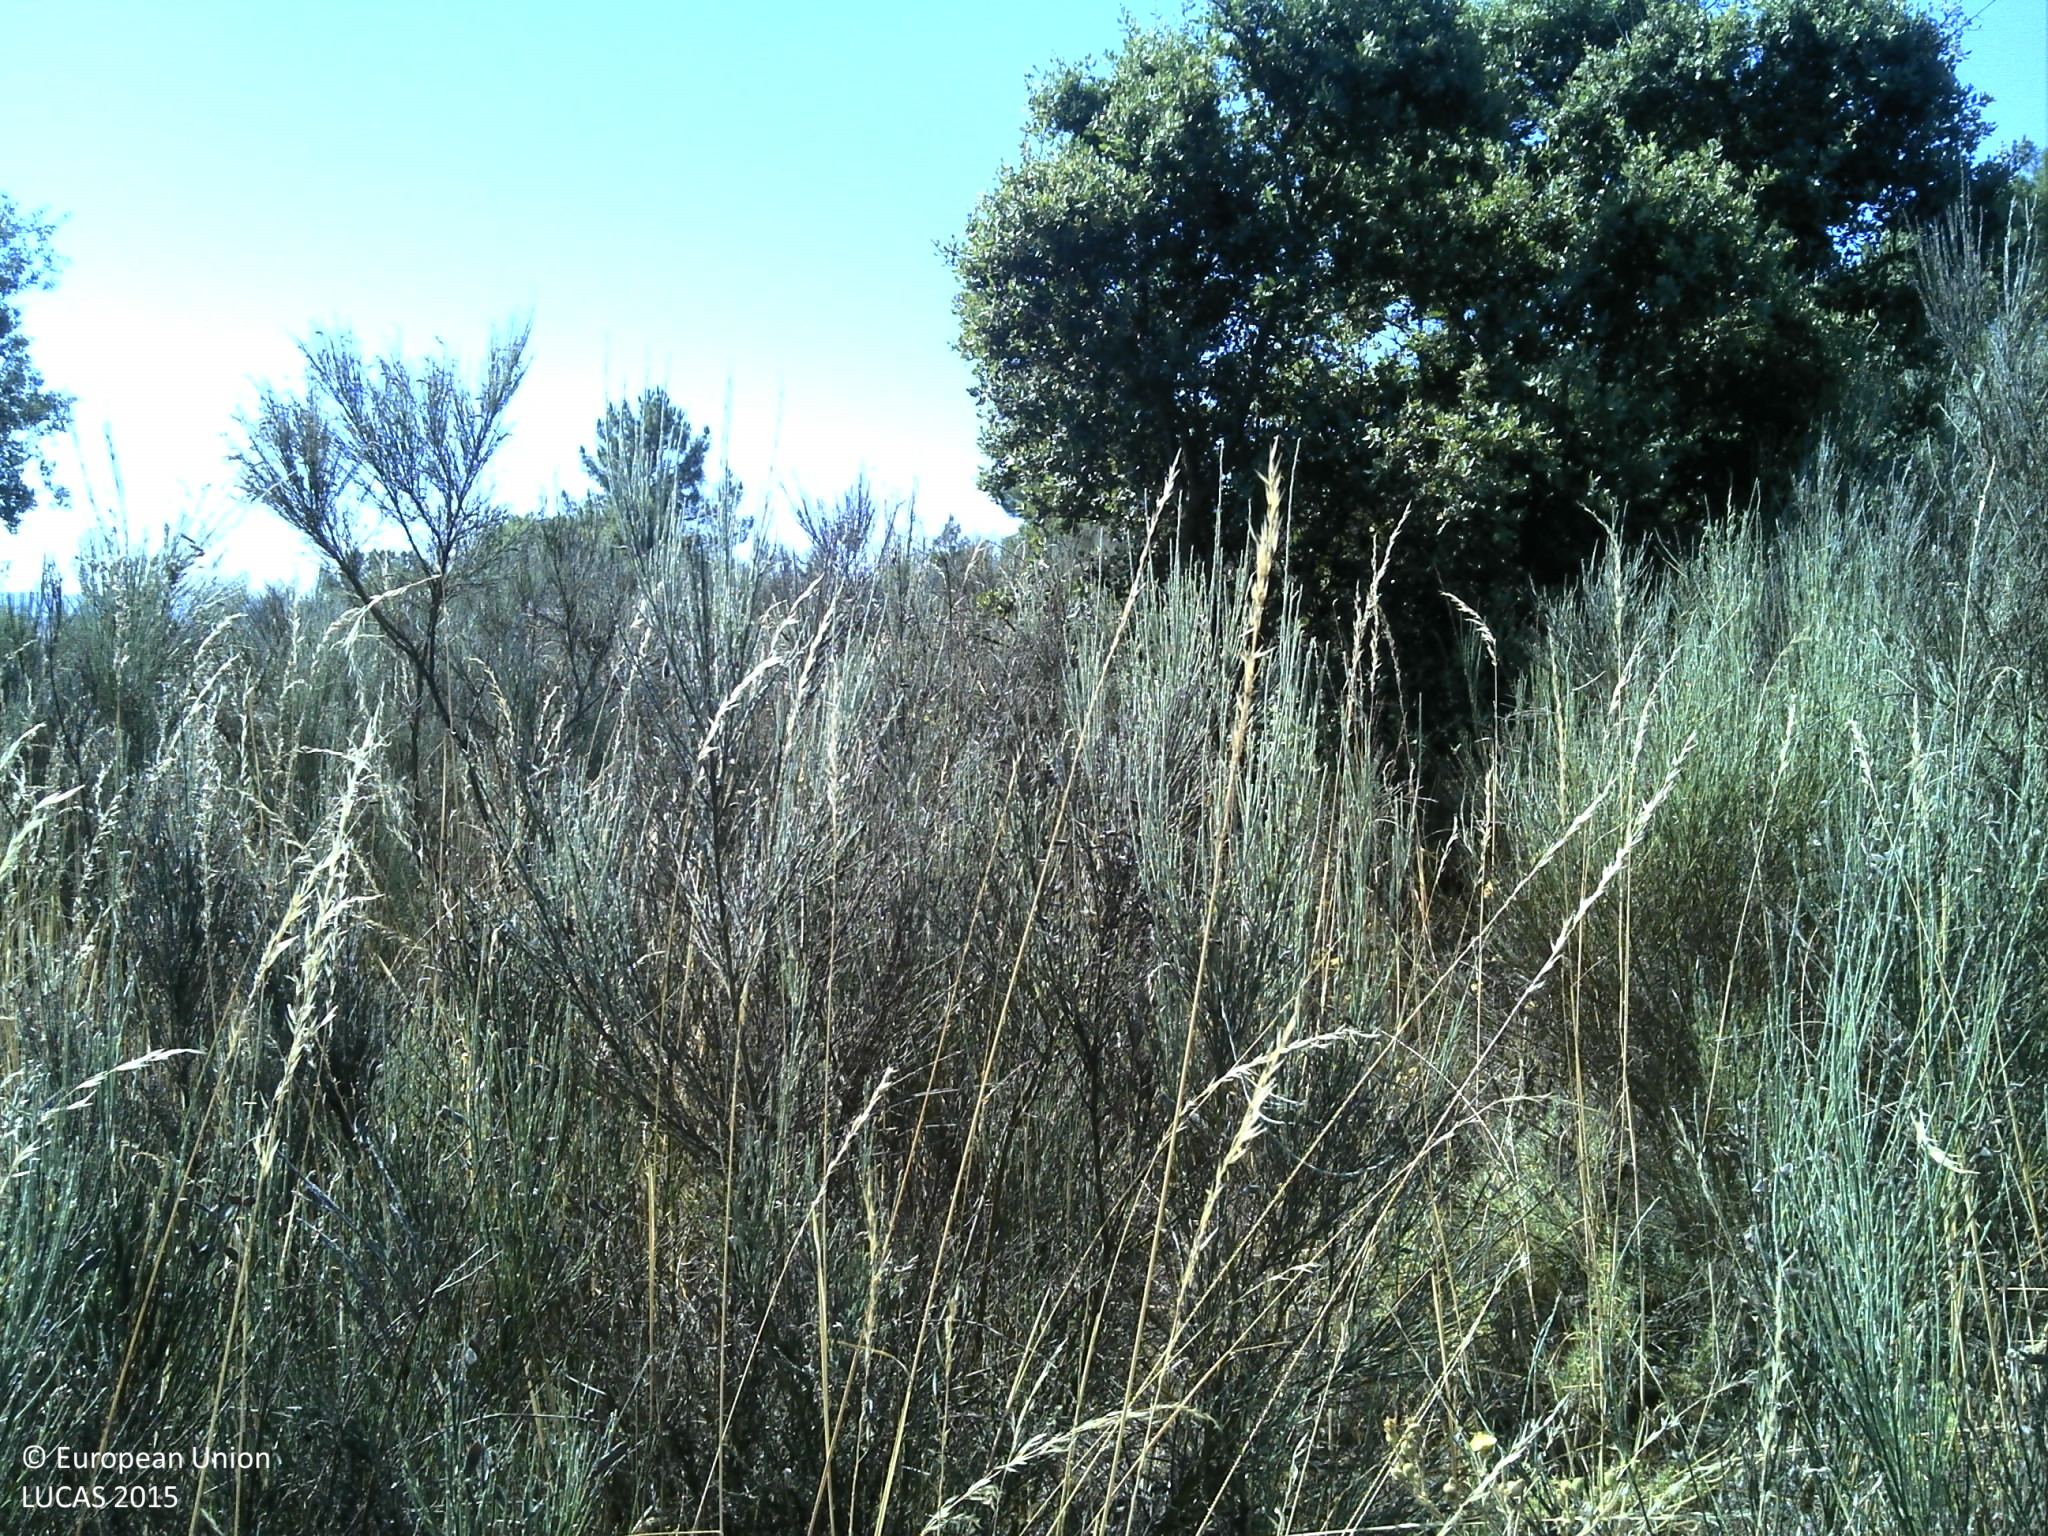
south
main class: Shrubland
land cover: Shrubland with sparse tree cover
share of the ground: 50 - 75 %
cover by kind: shrubs 60 %, herbaceous plants 15 %, consolidated bare surface 10 %, unconsolidated bare surface 10 %, broadleaved forest trees 5 %
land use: Semi-natural and natural areas not in use
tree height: > 5 m
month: June
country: PT
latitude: 40.8908
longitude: -7.2134
